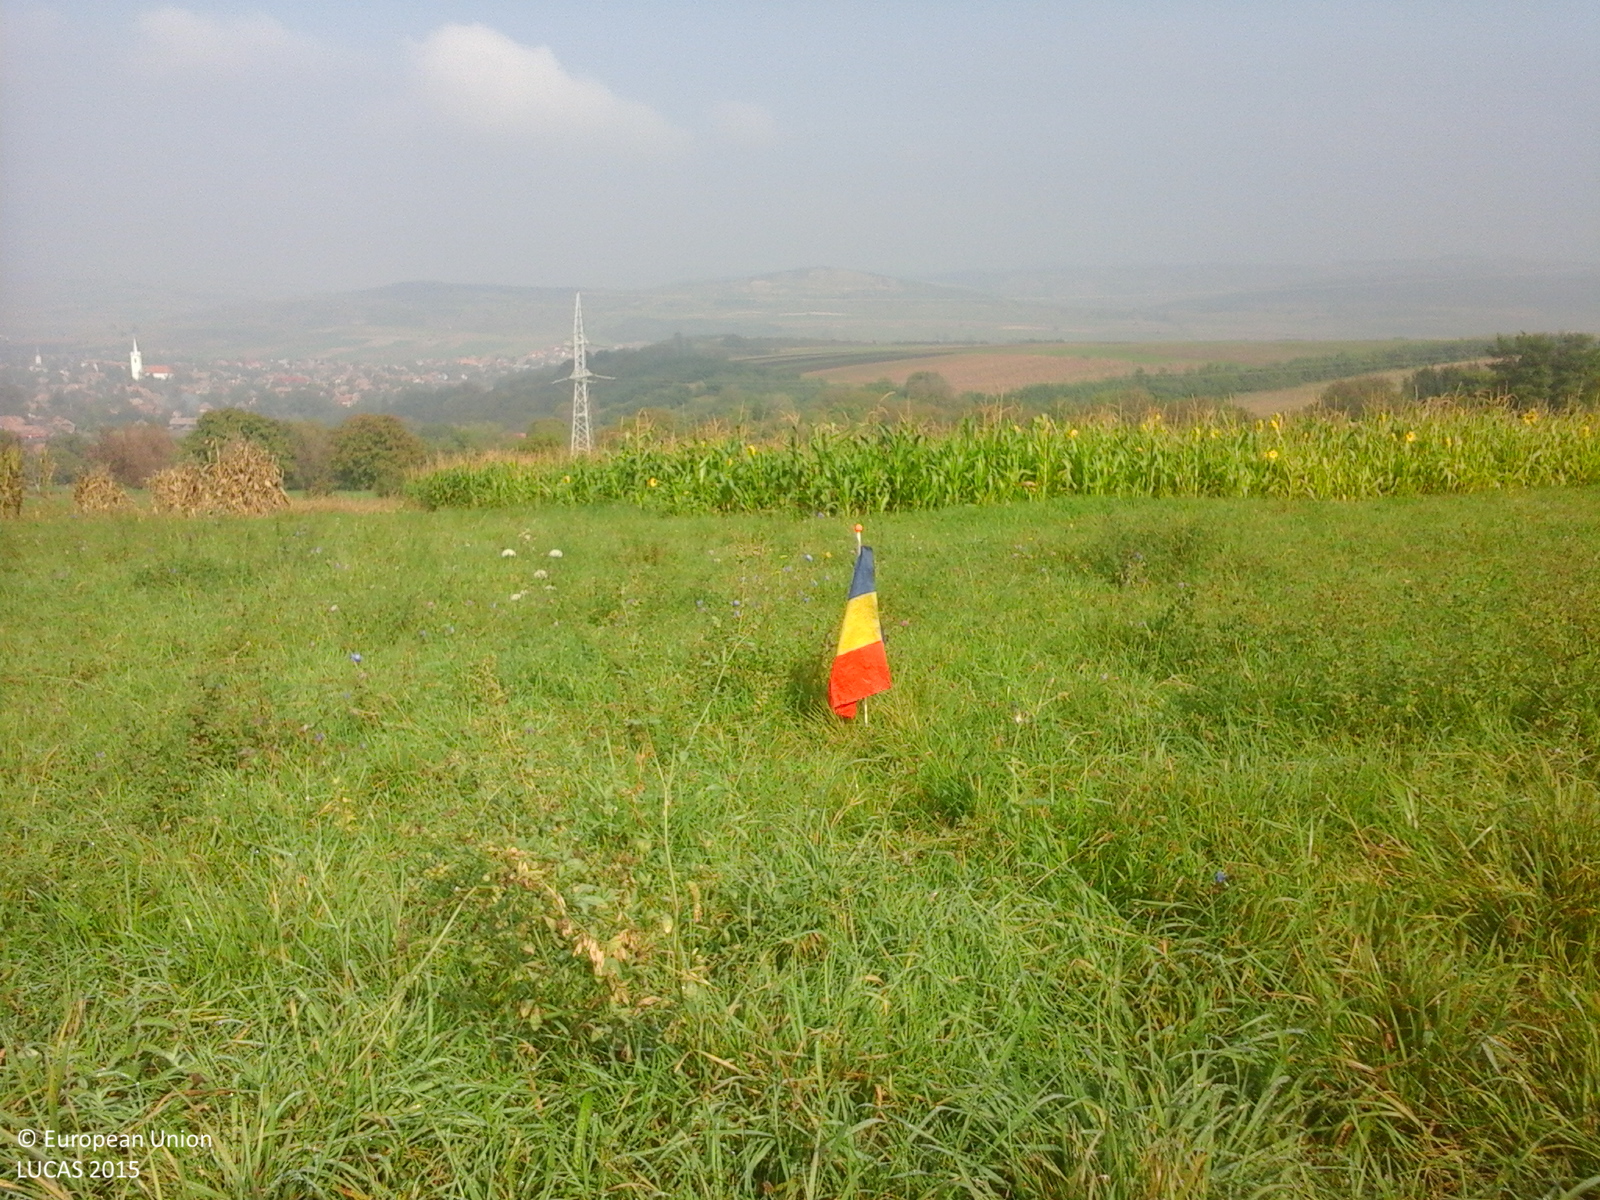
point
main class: Cropland
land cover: Other leguminous and mixtures for fodder
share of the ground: > 75 %
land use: Agriculture (excluding fallow land and kitchen gardens)
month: October
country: RO
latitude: 46.5631
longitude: 24.3692
